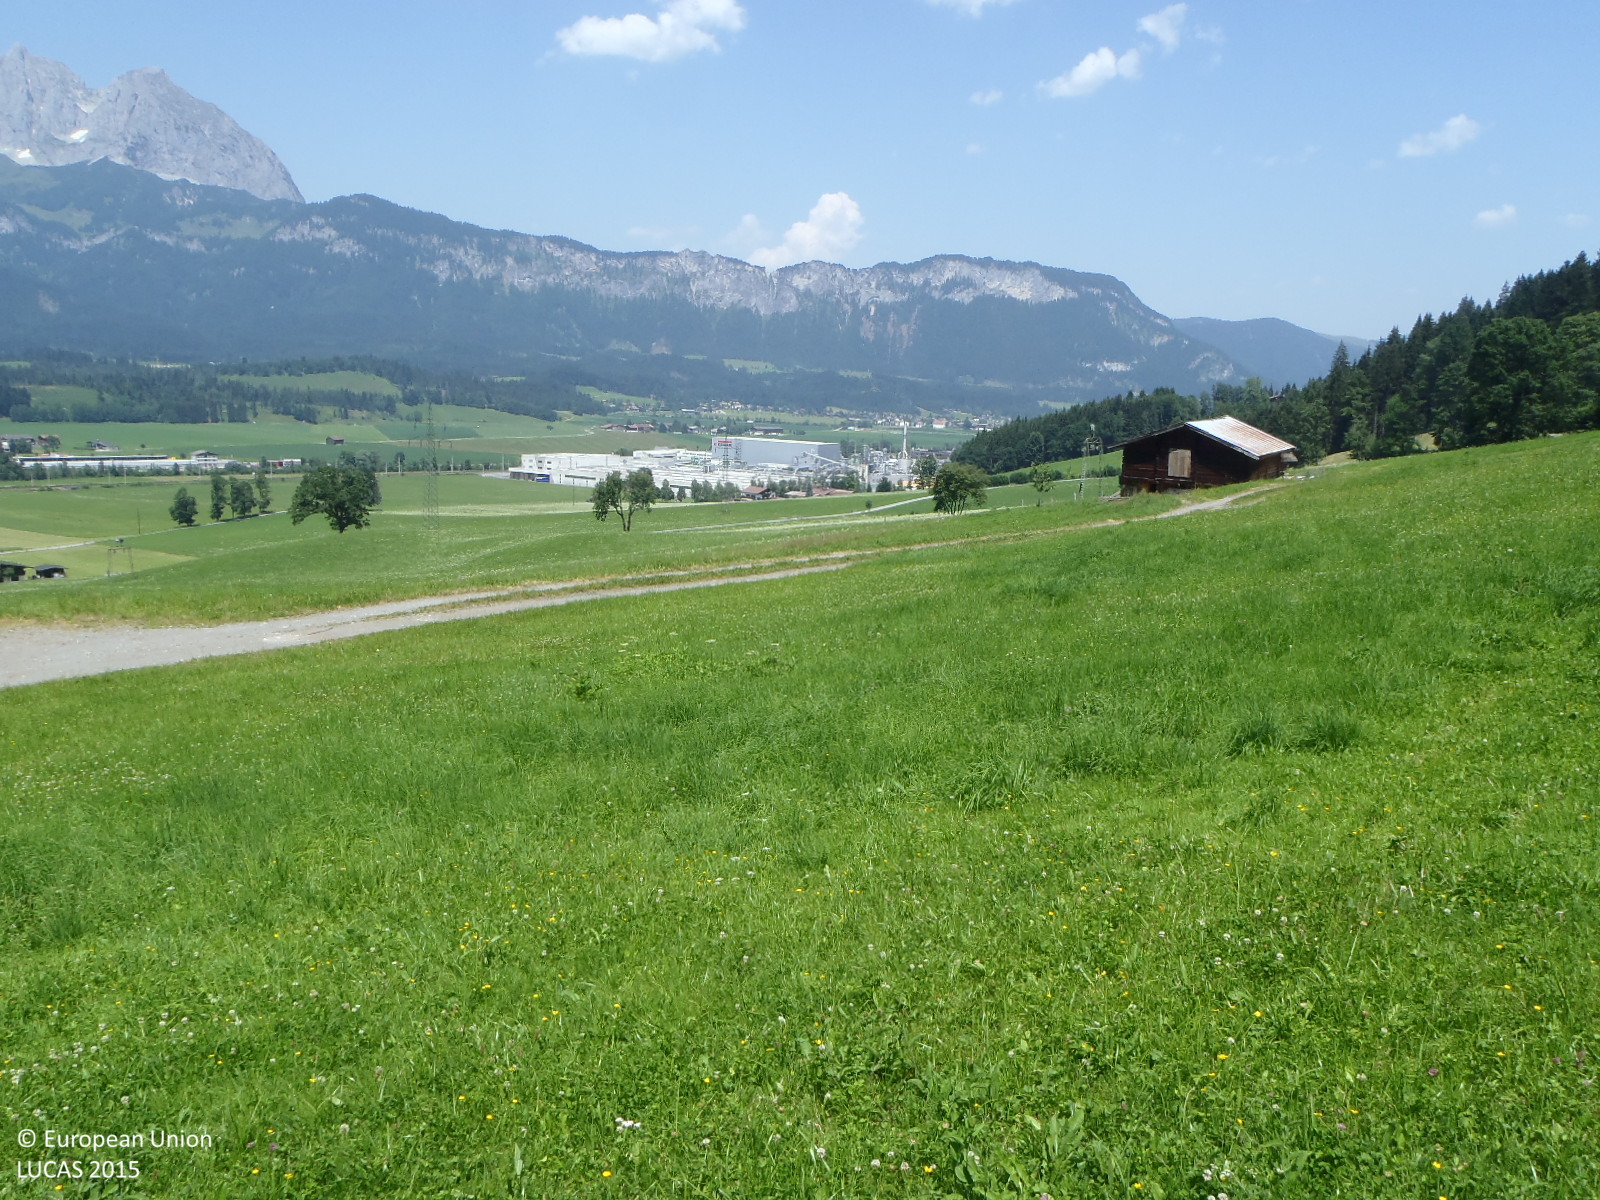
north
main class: Grassland
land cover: Grassland without tree/shrub cover
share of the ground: > 75 %
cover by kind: herbaceous plants 100 %
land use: Agriculture (excluding fallow land and kitchen gardens)
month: July
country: AT
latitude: 47.4952
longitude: 12.4009
